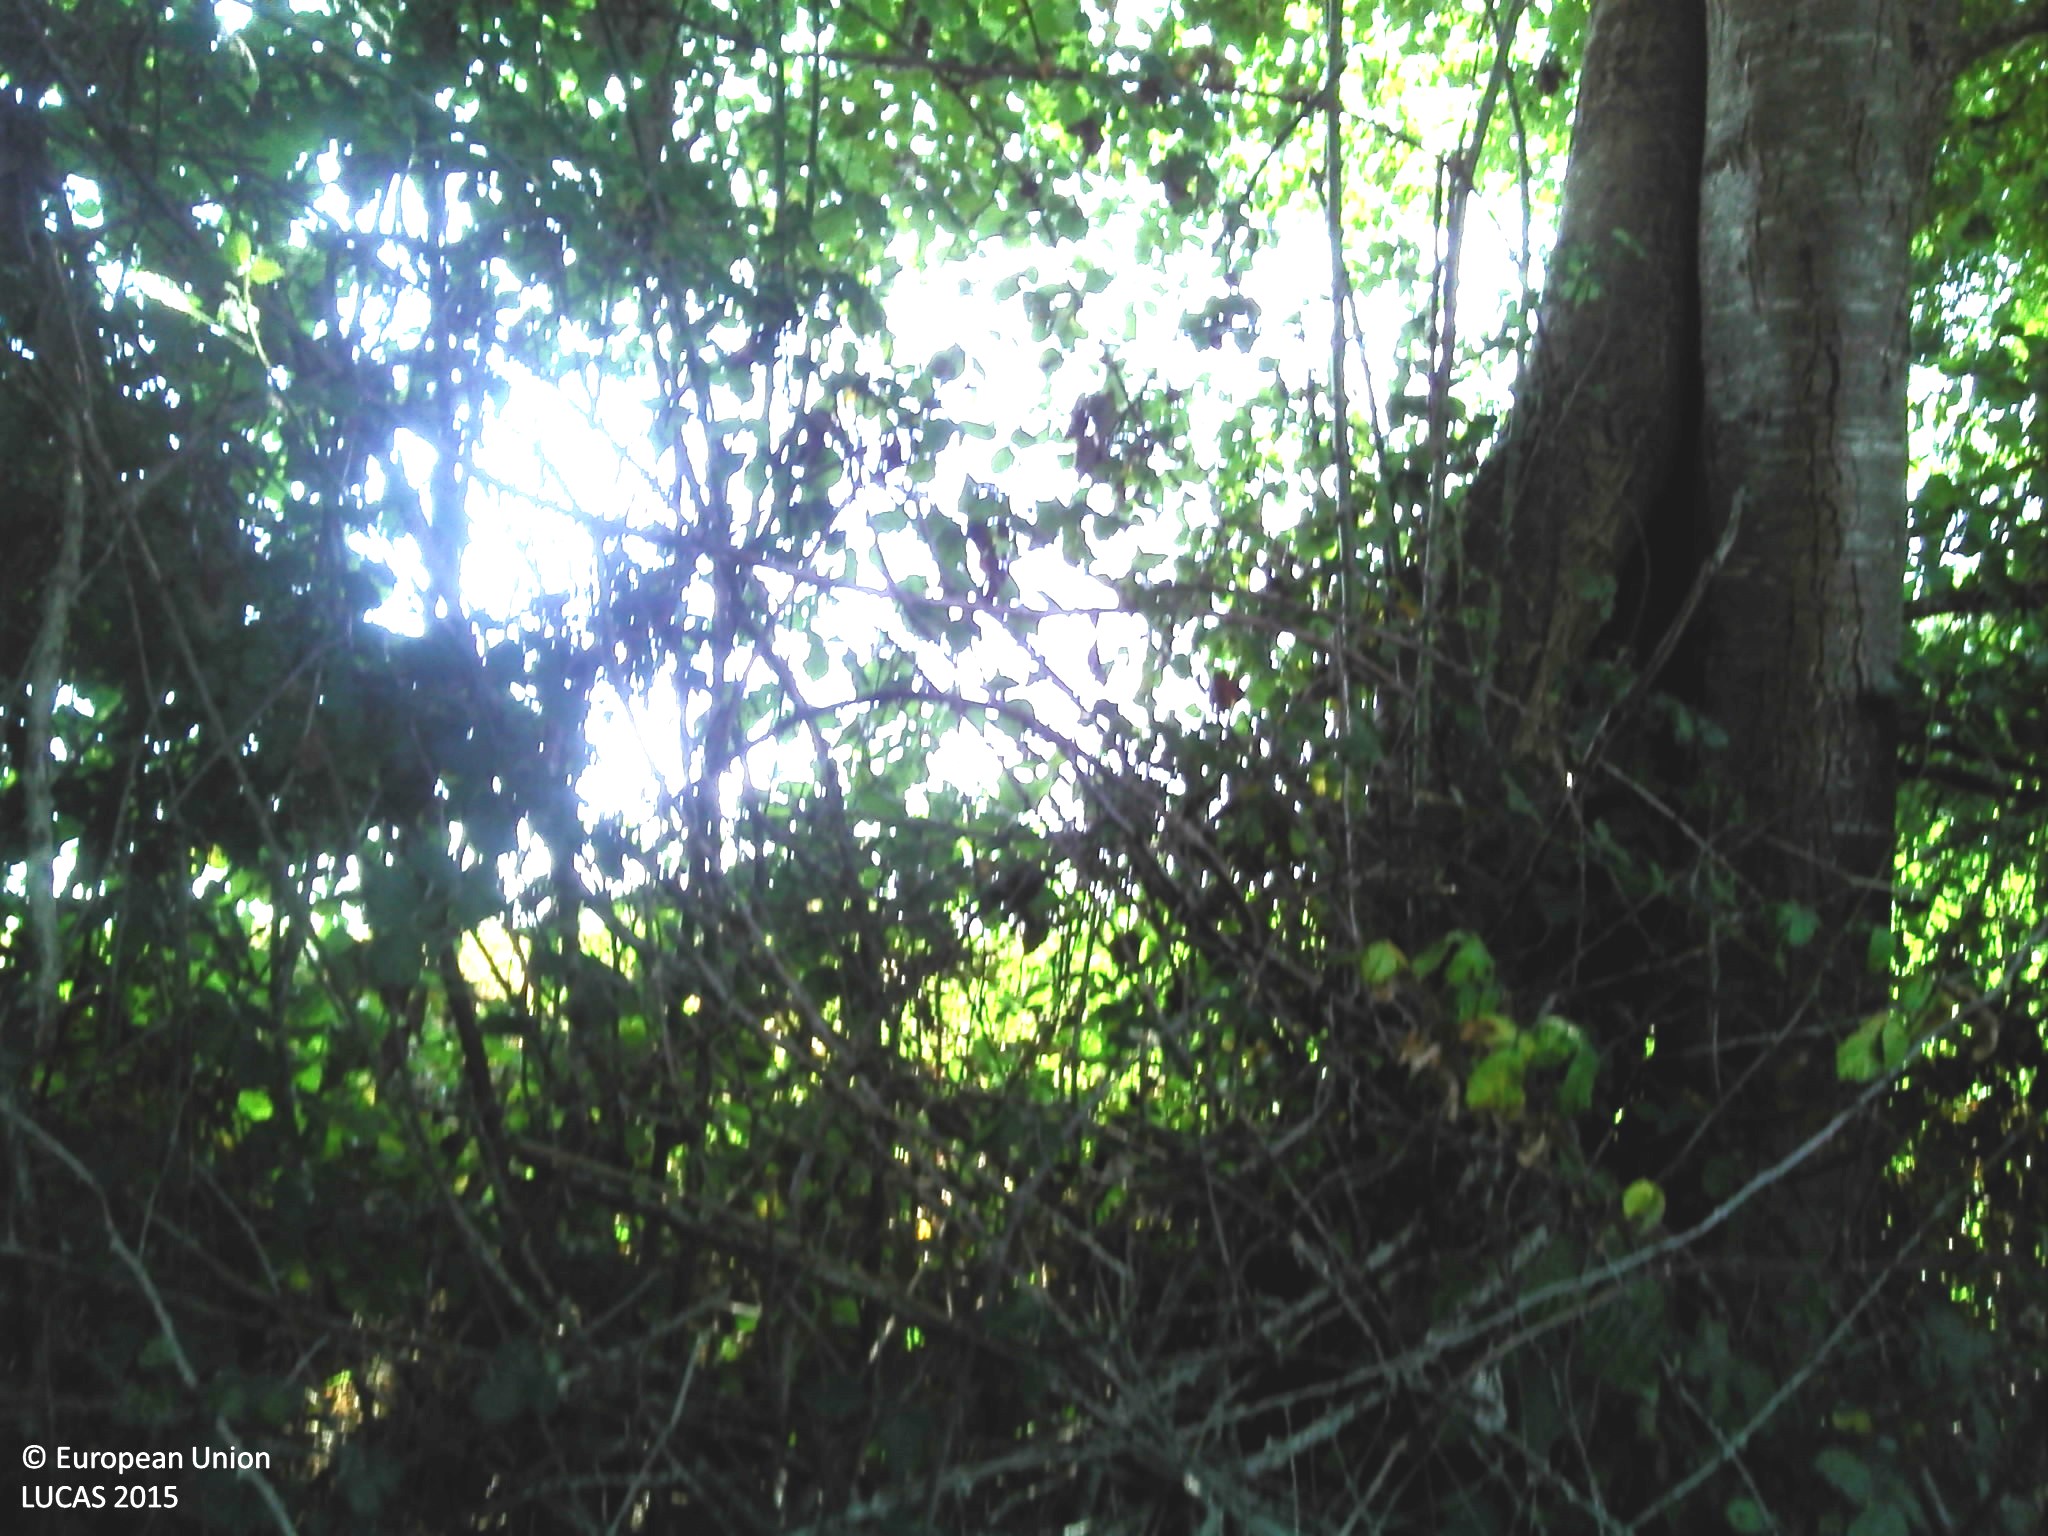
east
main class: Woodland
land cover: Broadleaved woodland
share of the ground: > 75 %
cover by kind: broadleaved forest trees 90 %, shrubs 10 %
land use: Agriculture (excluding fallow land and kitchen gardens)
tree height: > 5 m
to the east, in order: Rivers and streams; Broadleaved woodland; Grassland without tree/shrub cover; Fences; Managed hedges; Grass margins; Tracks; Grass margins; Managed hedges; Fences; Grassland without tree/shrub cover
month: July
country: FR
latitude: 46.5352
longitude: 2.1832
